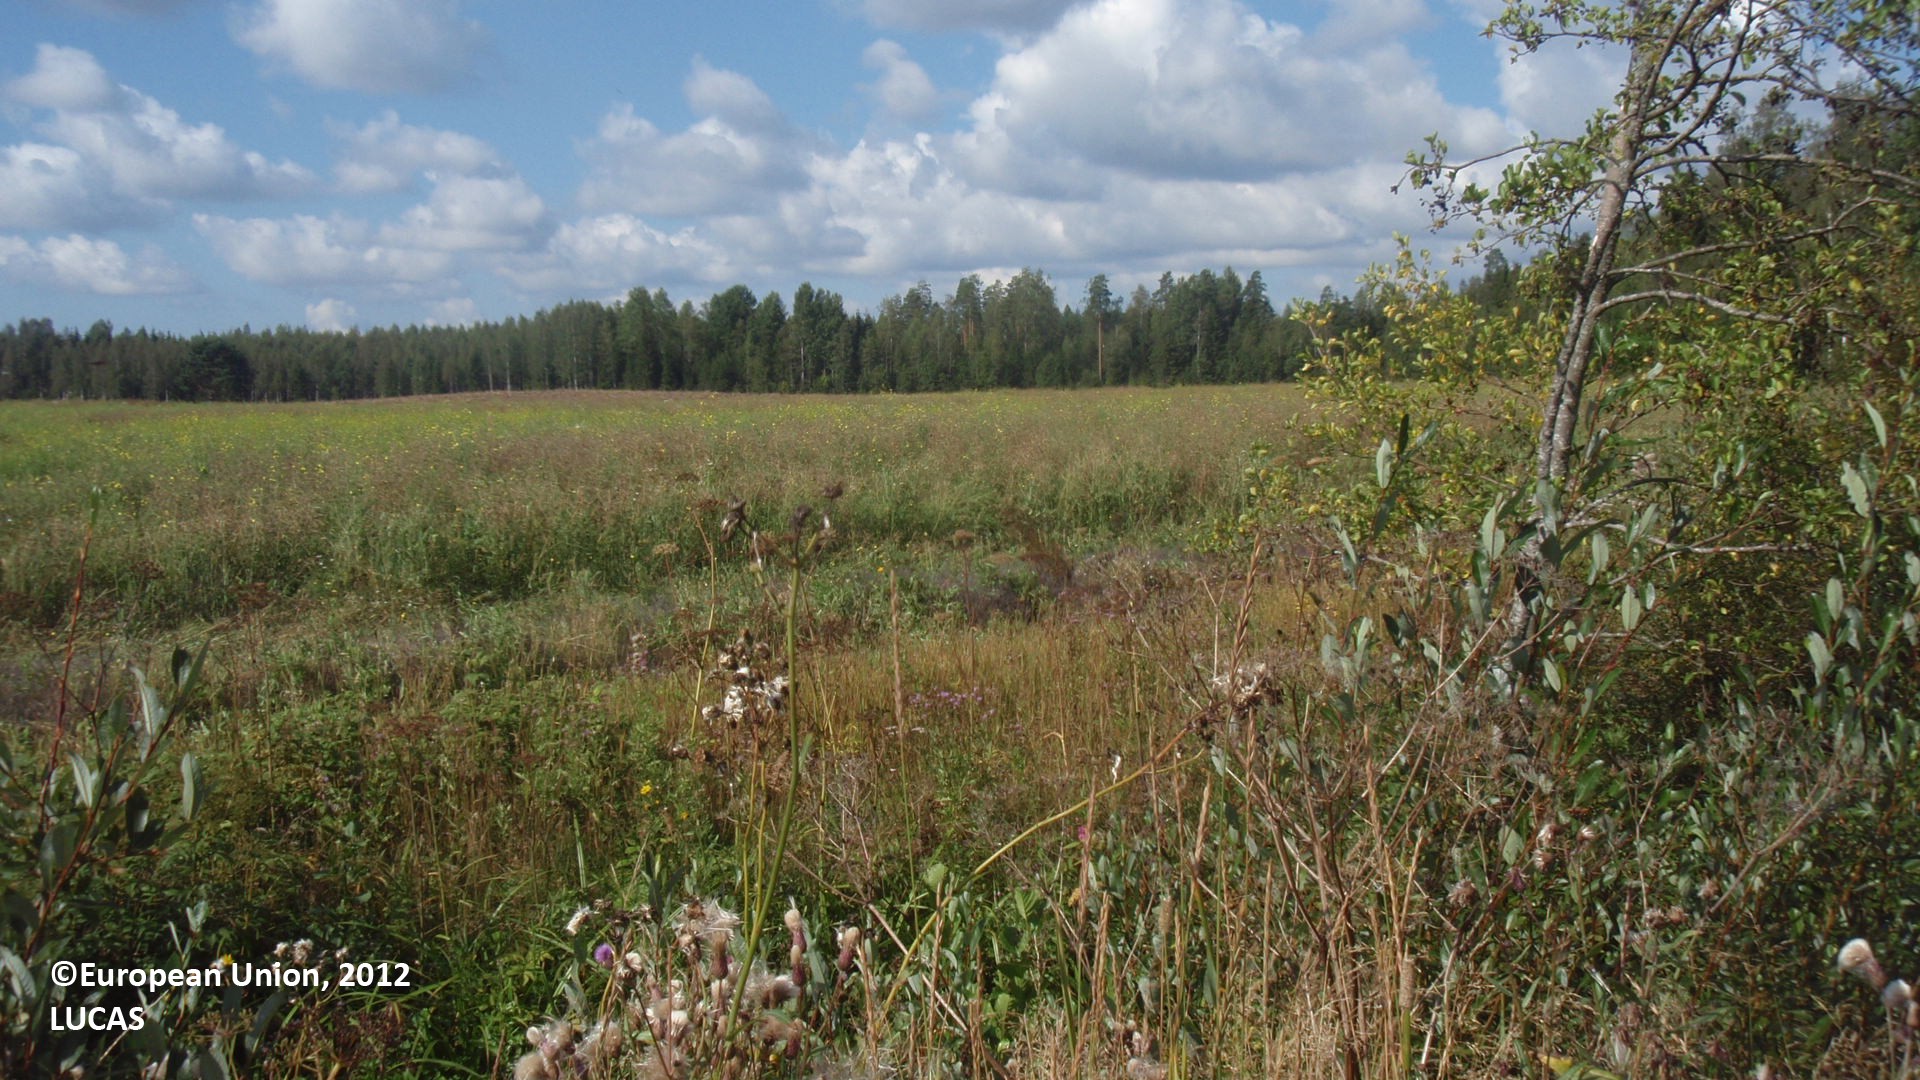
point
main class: Cropland
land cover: Temporary grasslands
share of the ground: > 75 %
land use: Agriculture (excluding fallow land and kitchen gardens)
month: August
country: FI
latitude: 60.7672
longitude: 26.6611
